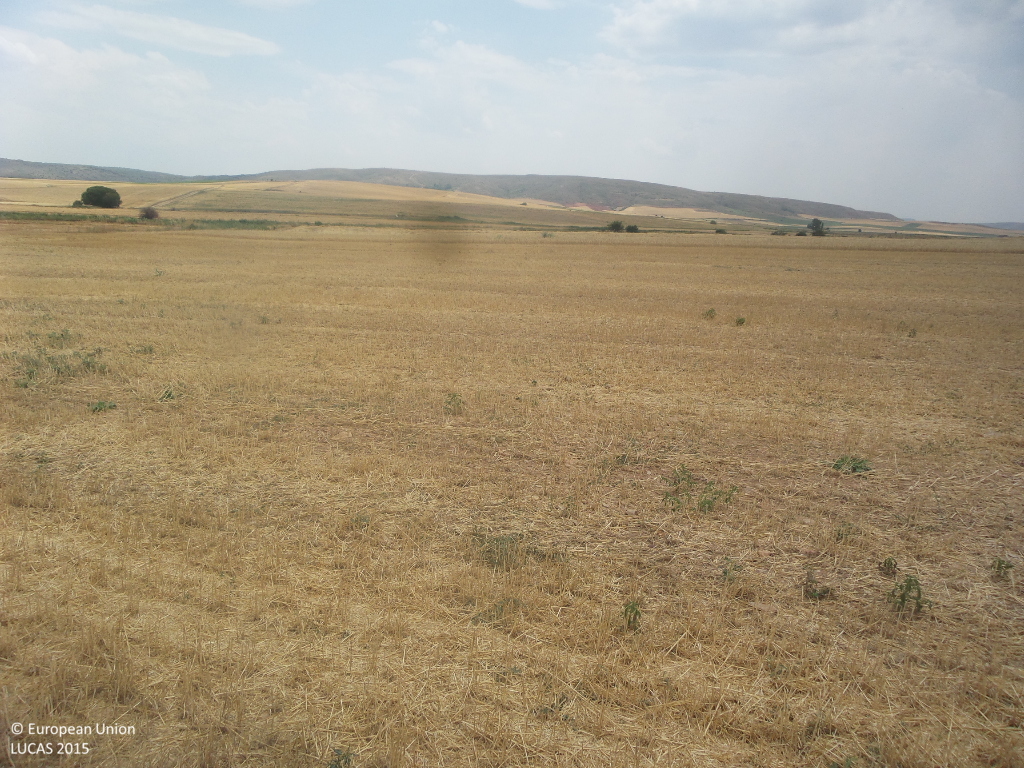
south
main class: Cropland
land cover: Common wheat
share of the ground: < 10 %
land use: Agriculture (excluding fallow land and kitchen gardens)
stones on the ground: < 10 %
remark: Harvested field
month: July
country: ES
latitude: 41.2131
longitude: -2.6891
